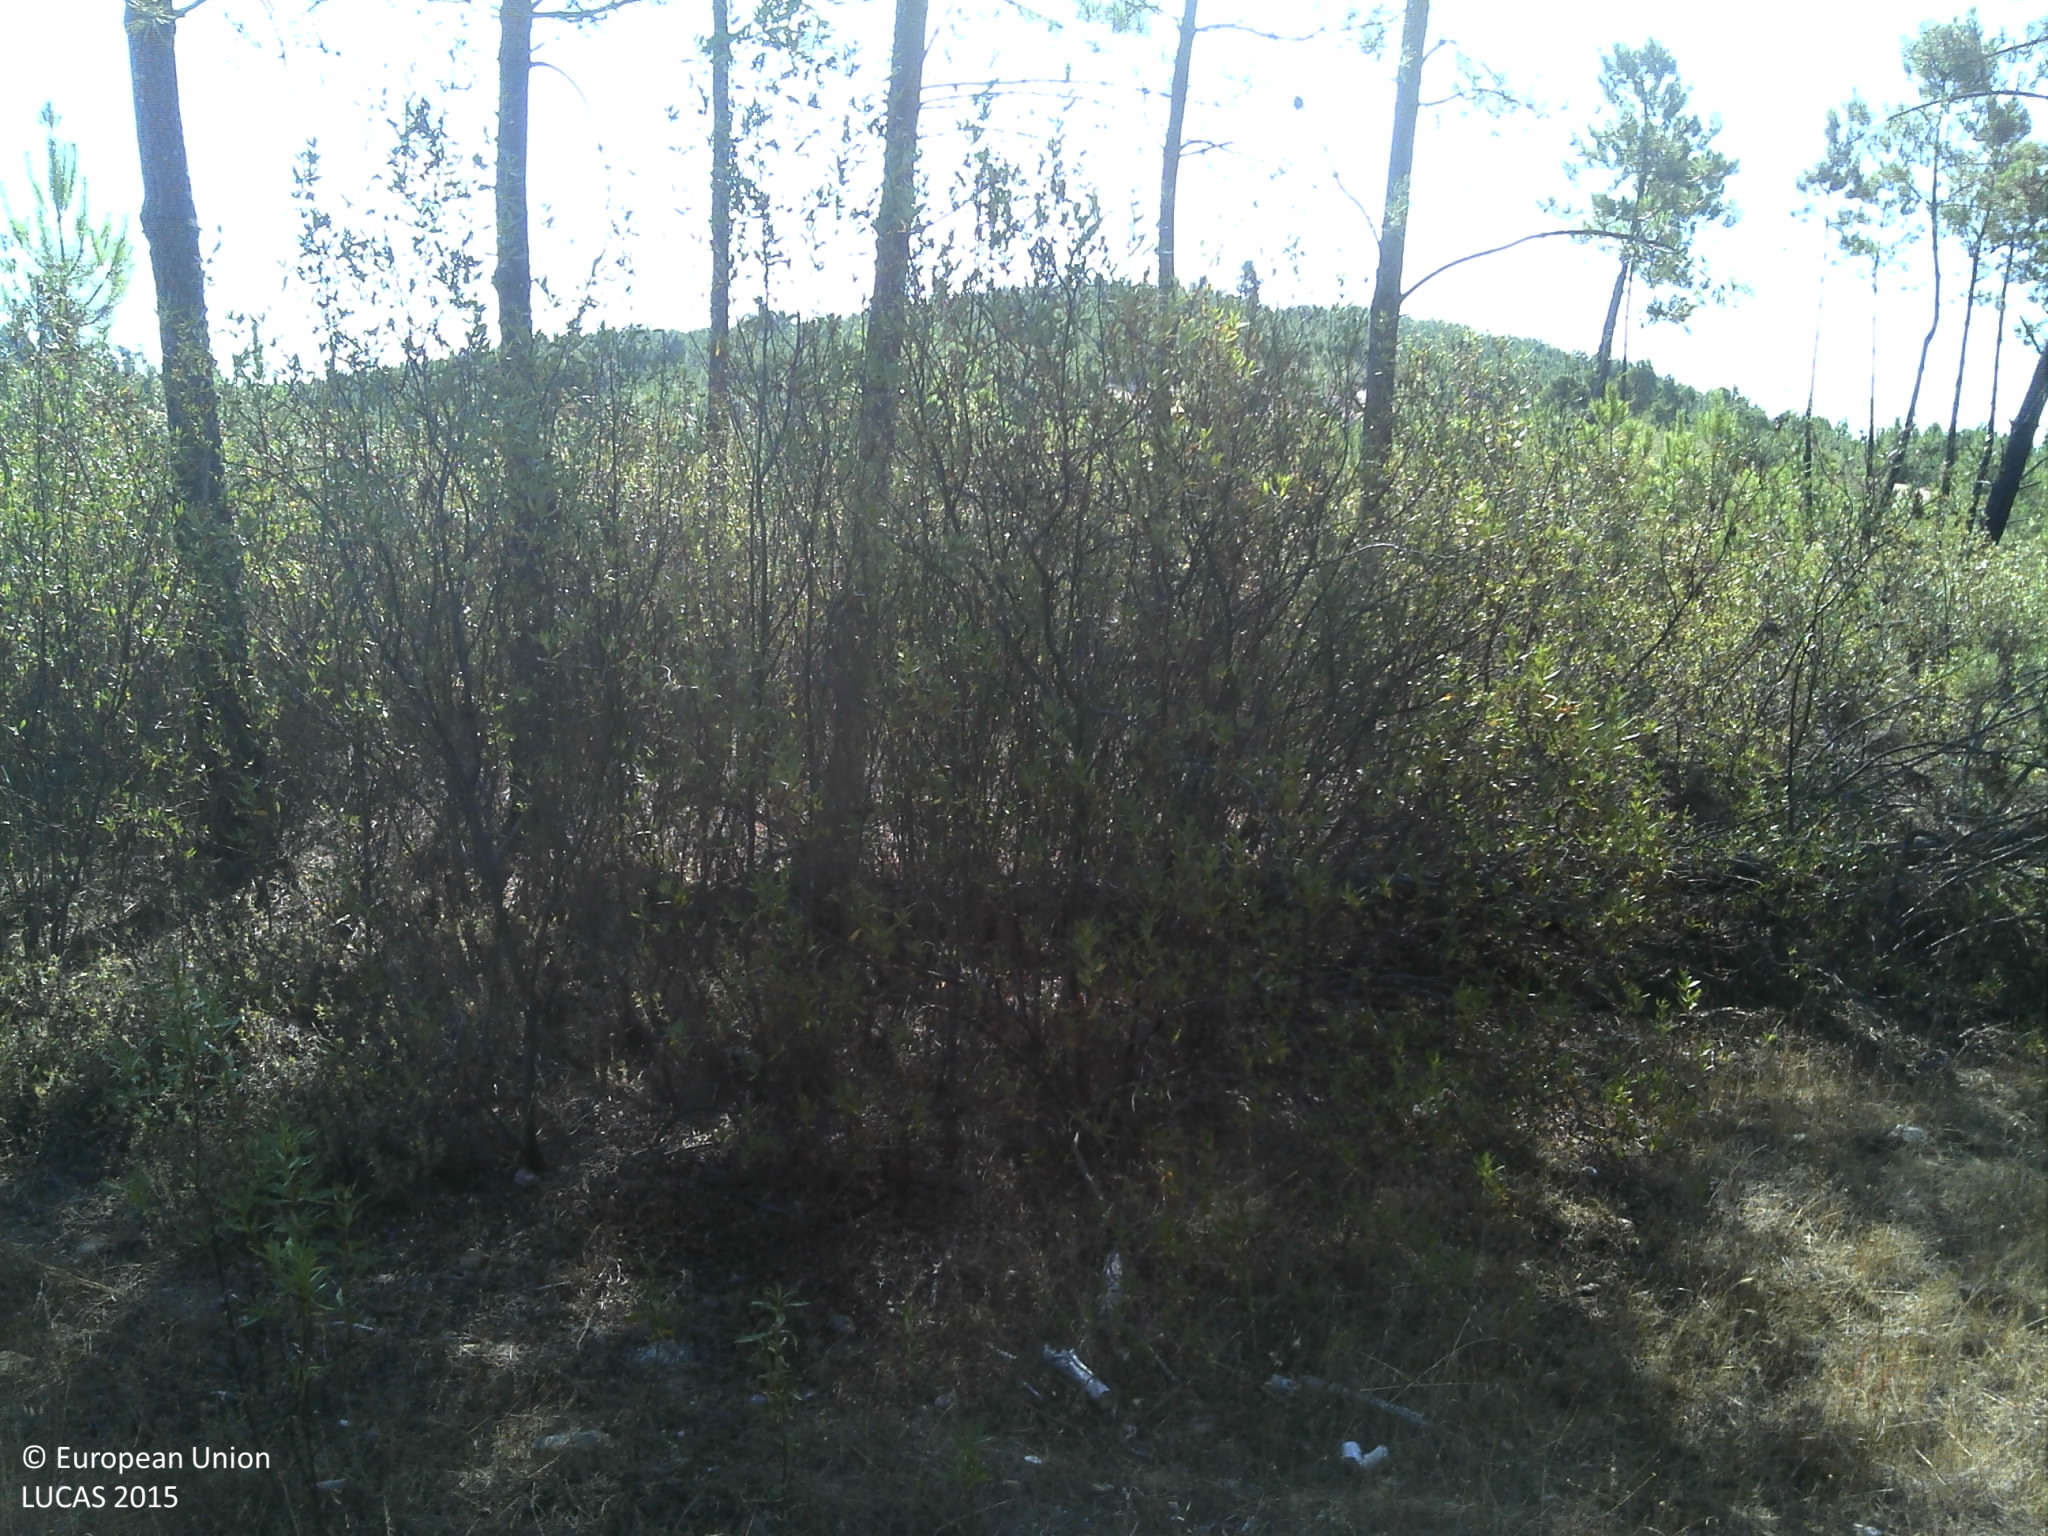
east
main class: Woodland
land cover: Pine dominated coniferous woodland
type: coniferous forest of the mediterranean region
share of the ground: 25 - 50 %
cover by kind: coniferous forest trees 30 %, shrubs 30 %, unconsolidated bare surface 30 %, herbaceous plants 10 %
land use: Forestry
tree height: > 5 m
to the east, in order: Pine dominated coniferous woodland; Shrubland without tree cover; Pine dominated coniferous woodland; Tracks; Pine dominated coniferous woodland; Tracks; Pine dominated coniferous woodland; Tracks; Pine dominated coniferous woodland; Other bare soil; Pine dominated coniferous woodland
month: July
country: PT
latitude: 39.5228
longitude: -7.9376
